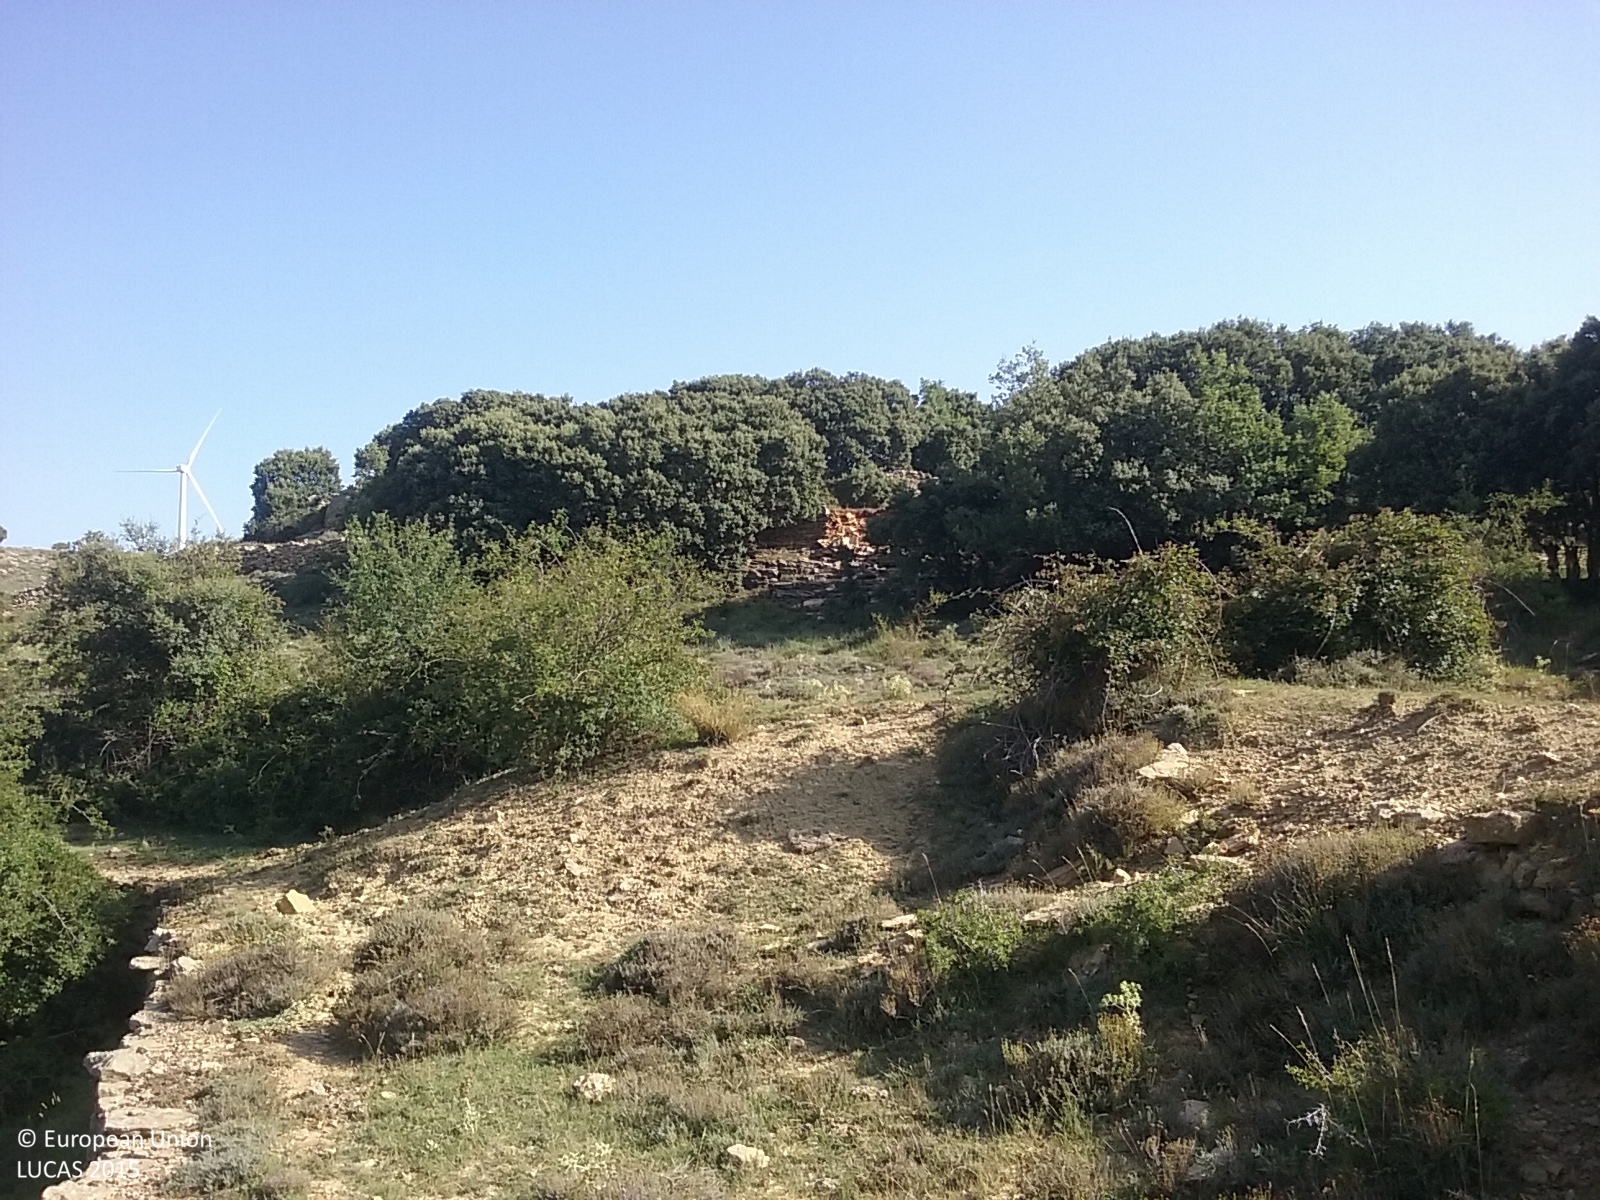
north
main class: Grassland
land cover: Grassland without tree/shrub cover
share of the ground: > 75 %
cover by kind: herbaceous plants 95 %, shrubs 5 %
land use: Agriculture (excluding fallow land and kitchen gardens)
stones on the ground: < 10 %
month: August
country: ES
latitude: 40.4624
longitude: -0.2075
